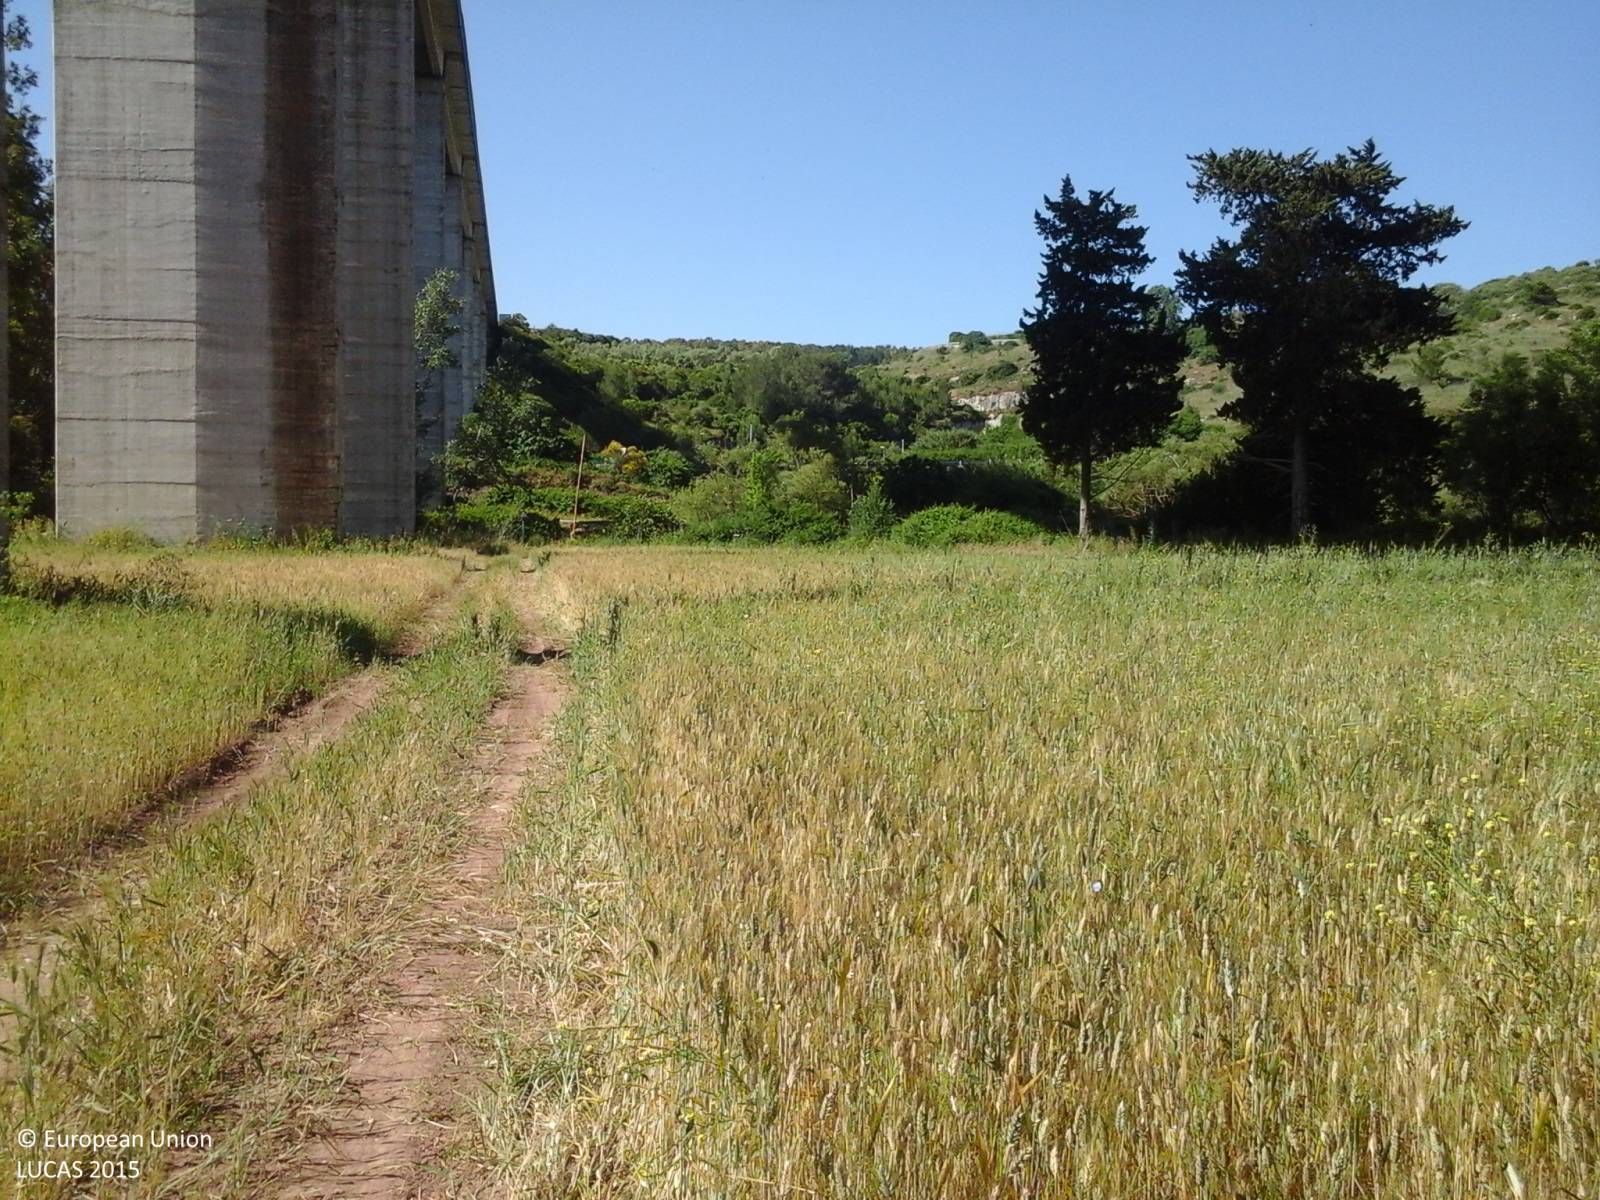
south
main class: Cropland
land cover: Durum wheat
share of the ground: > 75 %
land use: Agriculture (excluding fallow land and kitchen gardens)
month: May
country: IT
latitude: 40.6907
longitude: 8.5280
